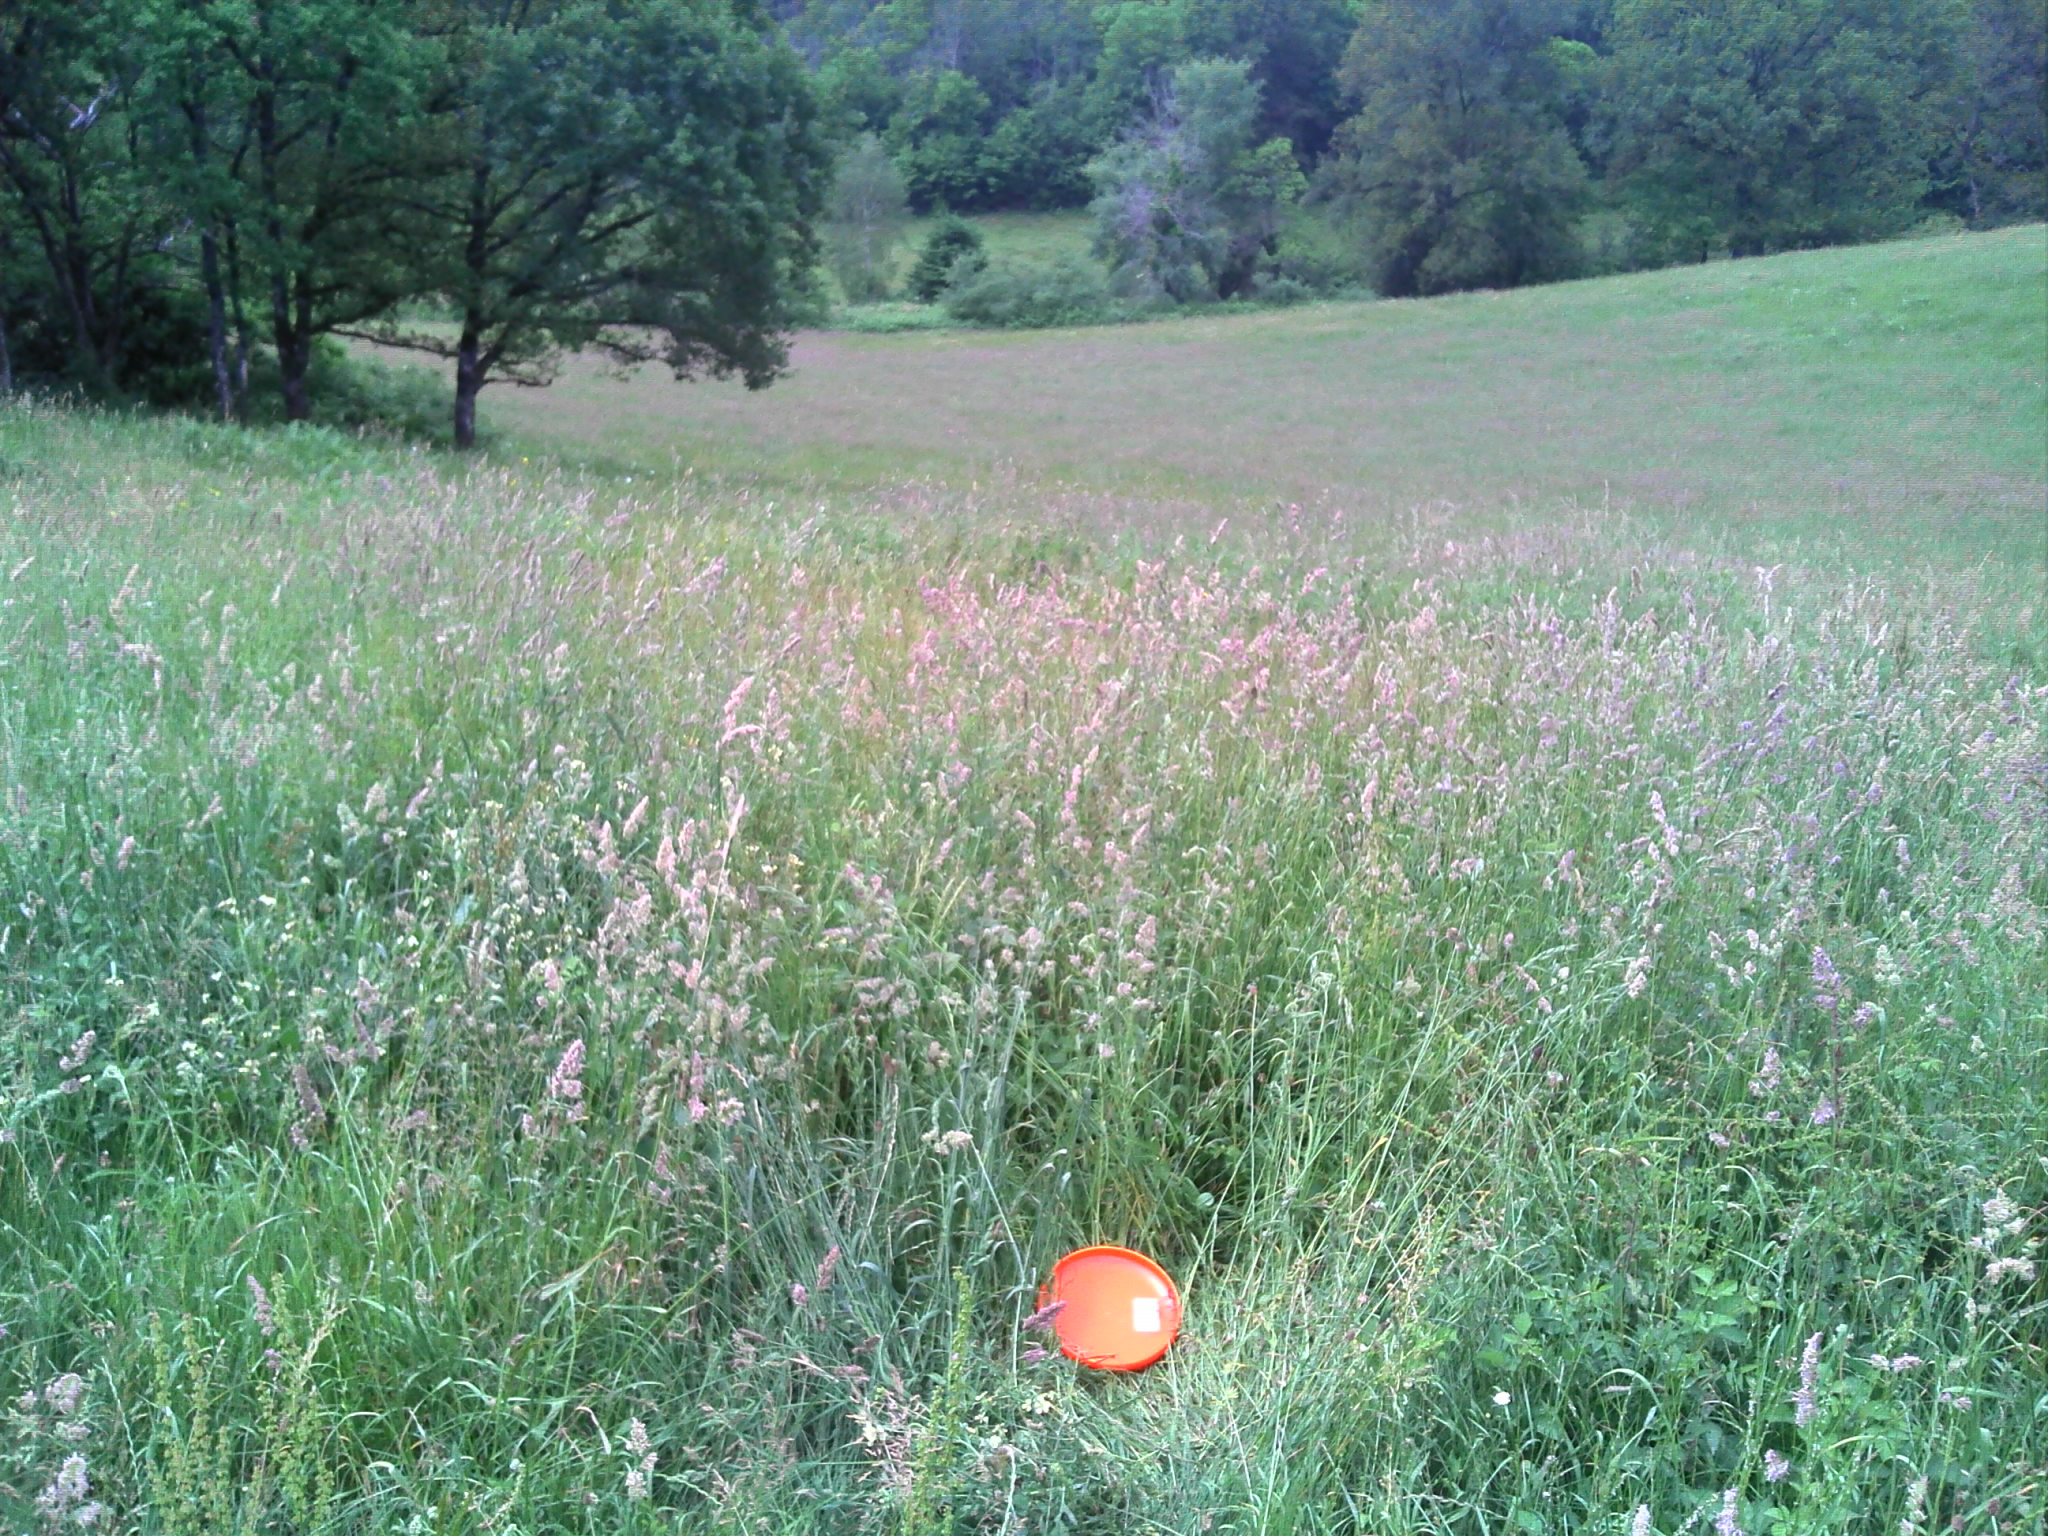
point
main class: Grassland
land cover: Grassland without tree/shrub cover
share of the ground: > 75 %
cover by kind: herbaceous plants 100 %
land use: Agriculture (excluding fallow land and kitchen gardens)
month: June
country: FR
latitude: 44.6925
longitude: 1.9868
